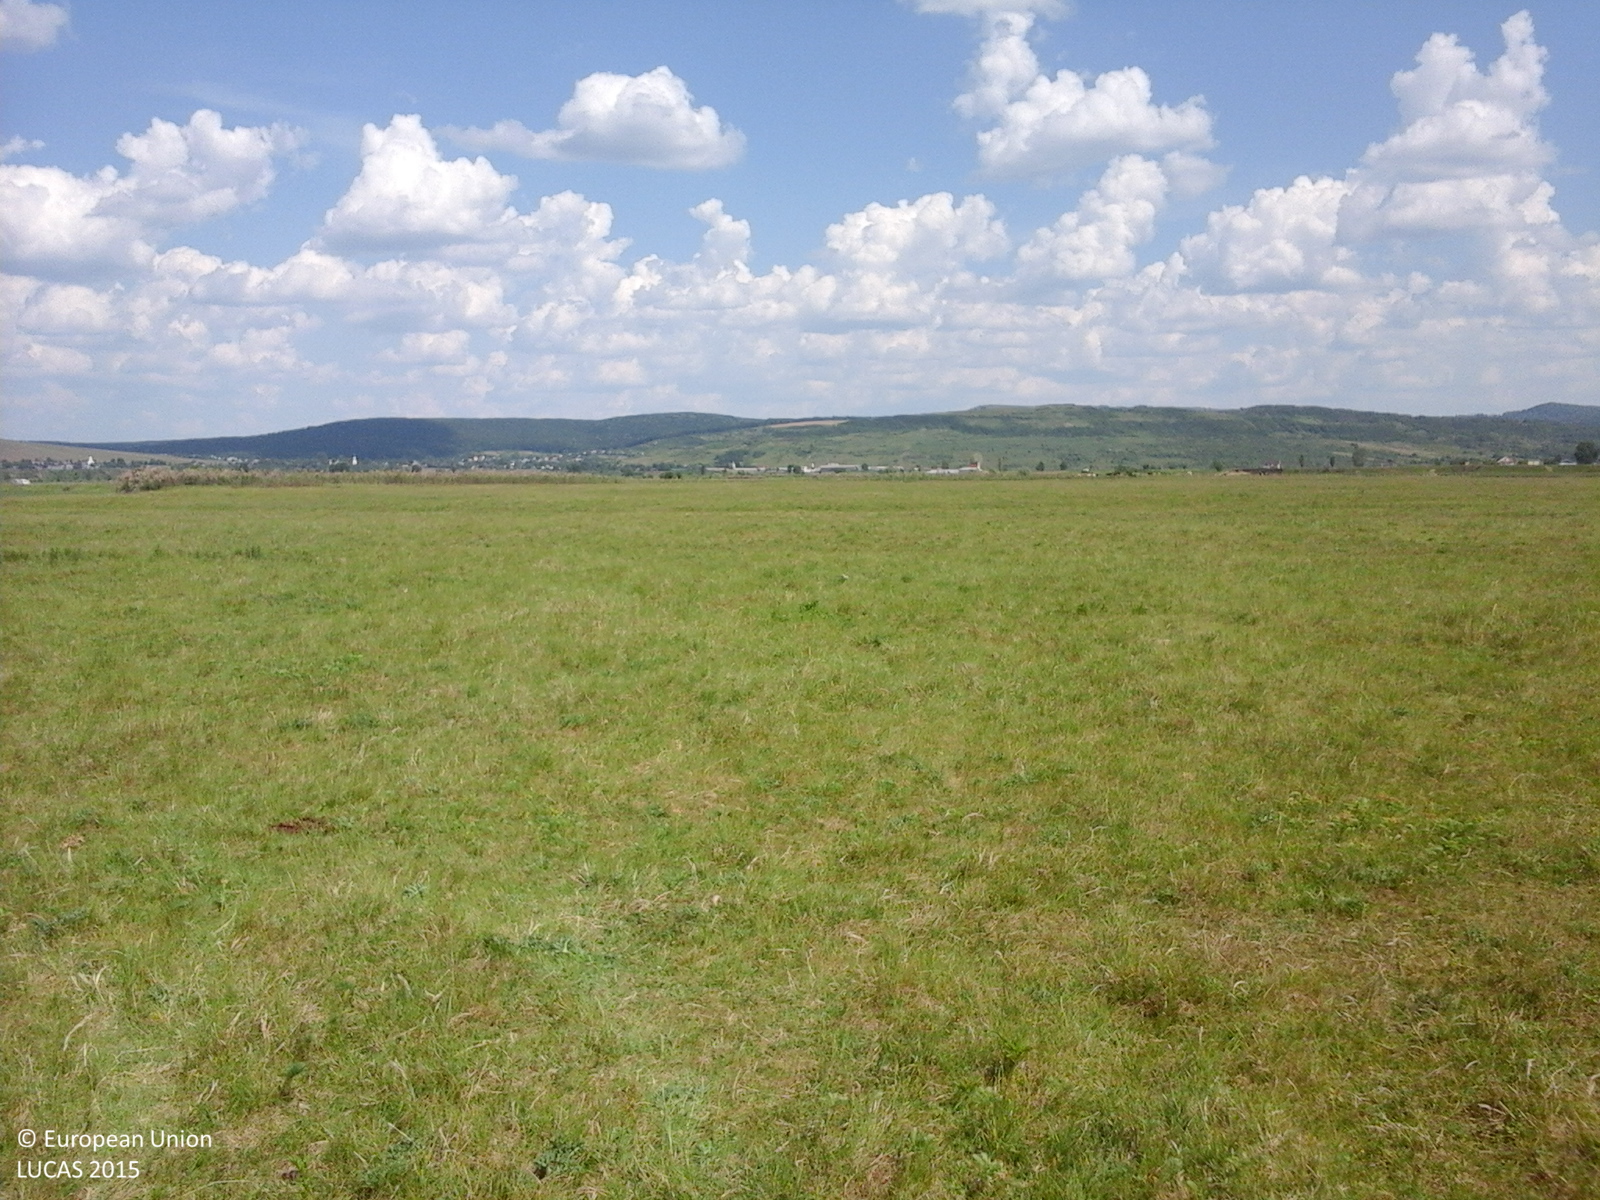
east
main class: Grassland
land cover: Grassland without tree/shrub cover
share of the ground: > 75 %
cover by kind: herbaceous plants 100 %
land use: Agriculture (excluding fallow land and kitchen gardens)
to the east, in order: Grassland without tree/shrub cover; Tracks; Grassland without tree/shrub cover
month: June
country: RO
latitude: 46.5999
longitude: 26.9750
